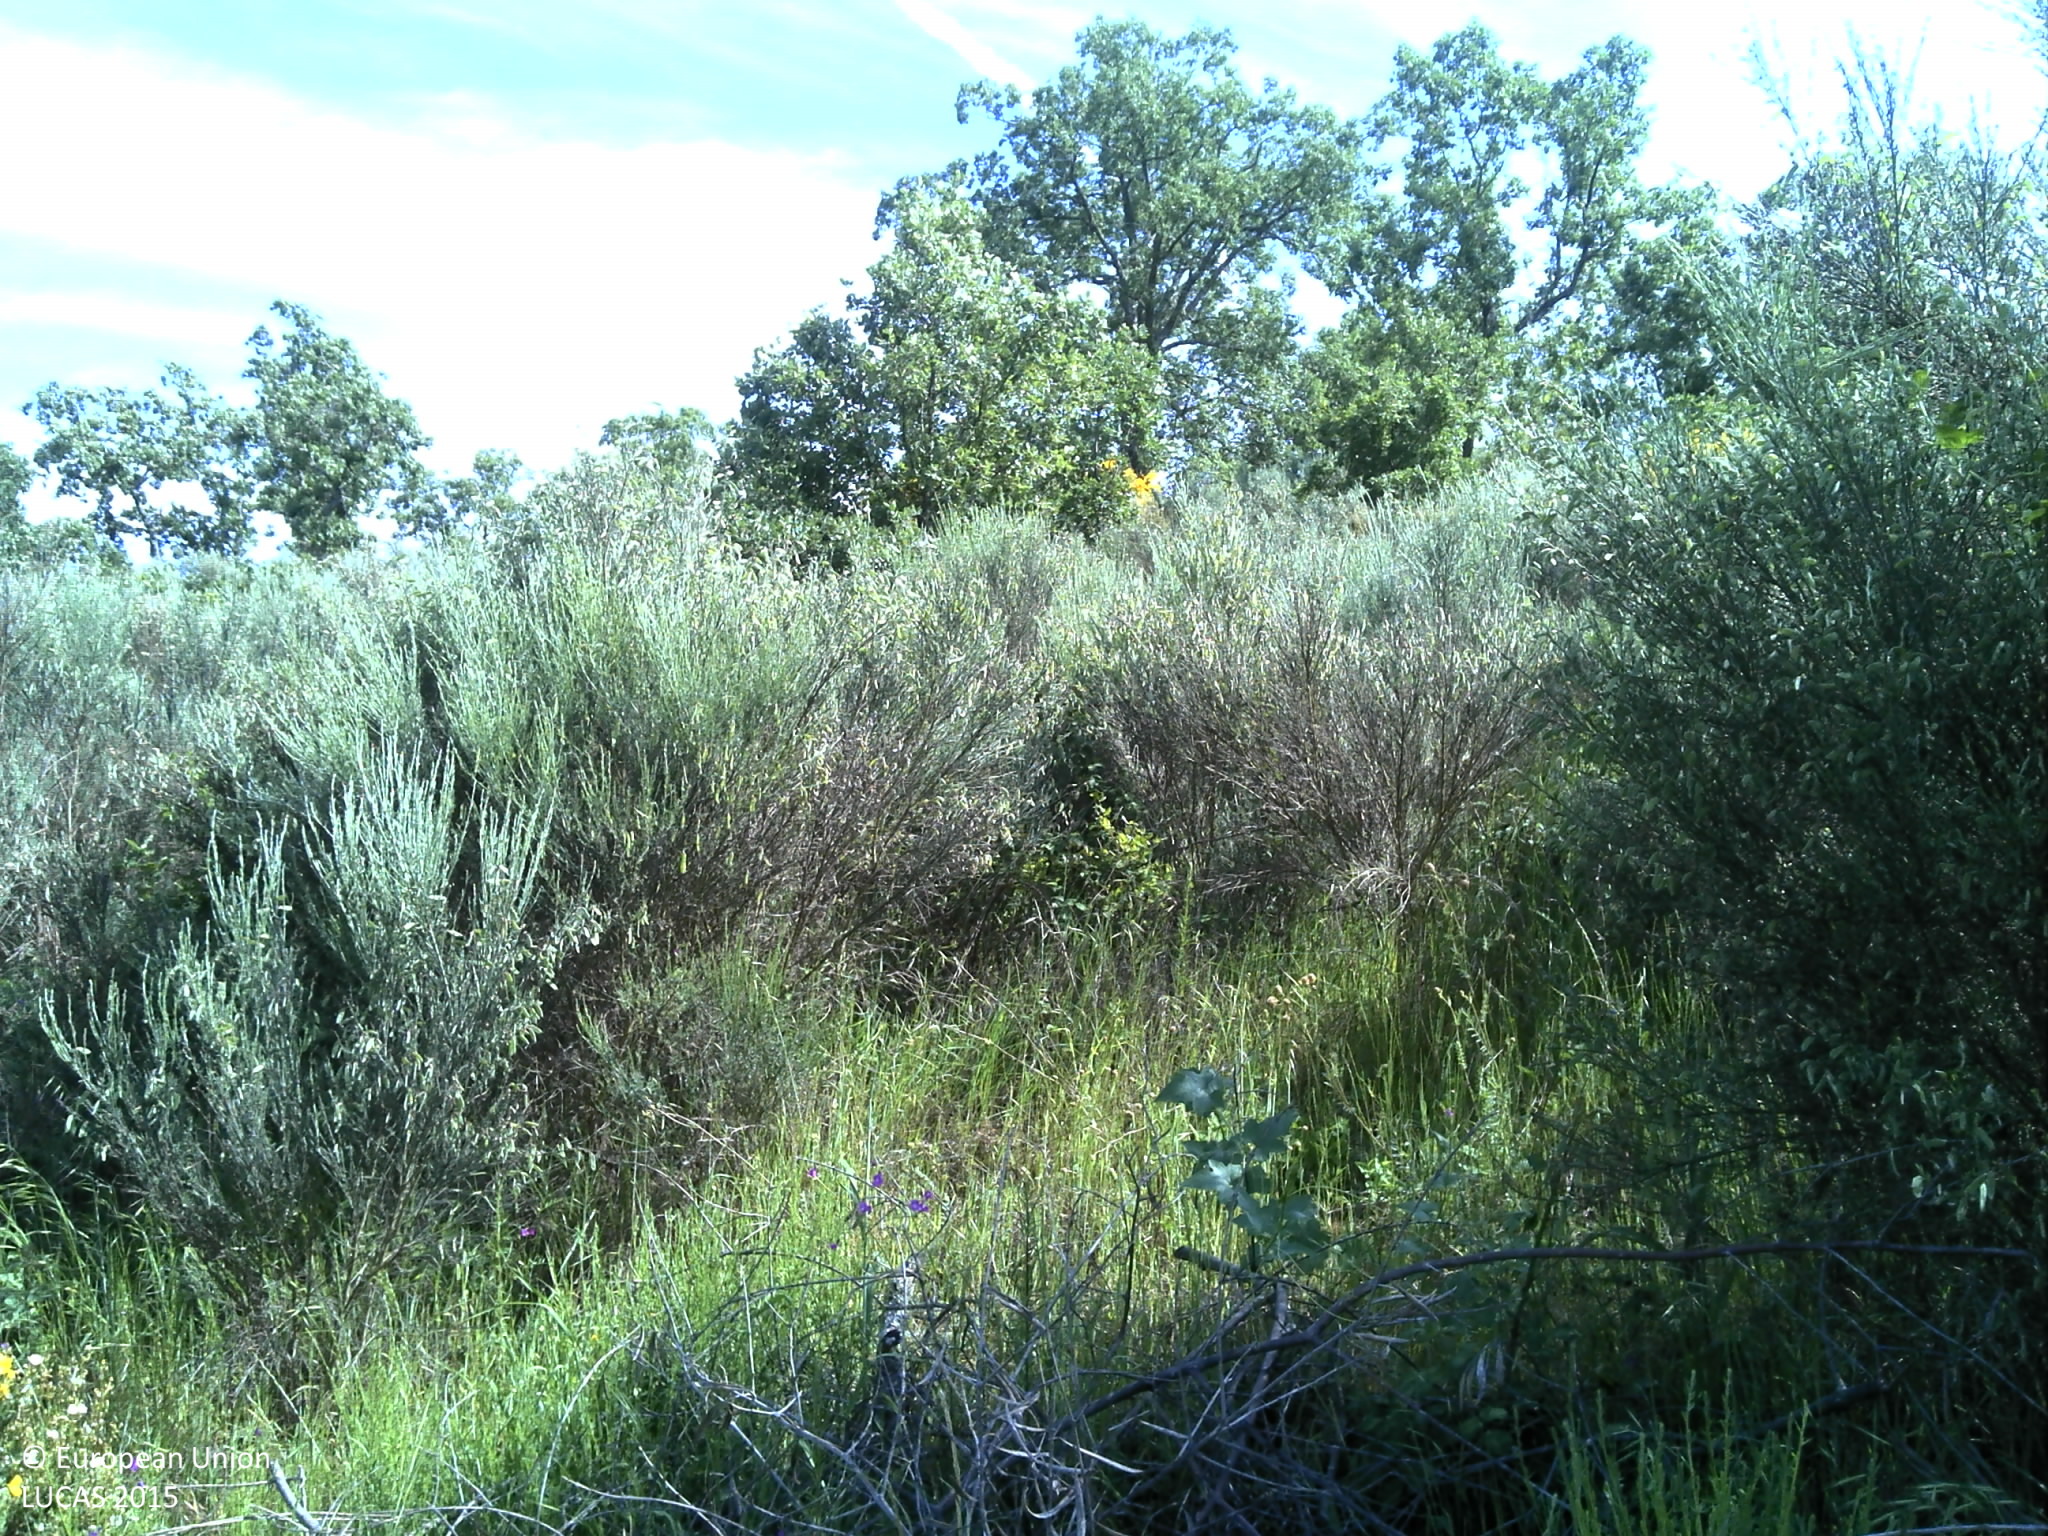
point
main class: Woodland
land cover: Broadleaved woodland
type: thermophilous deciduous forest
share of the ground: 10 - 25 %
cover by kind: shrubs 70 %, broadleaved forest trees 15 %, herbaceous plants 10 %, unconsolidated bare surface 5 %
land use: Forestry
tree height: > 5 m
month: May
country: PT
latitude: 41.6016
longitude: -7.0468
